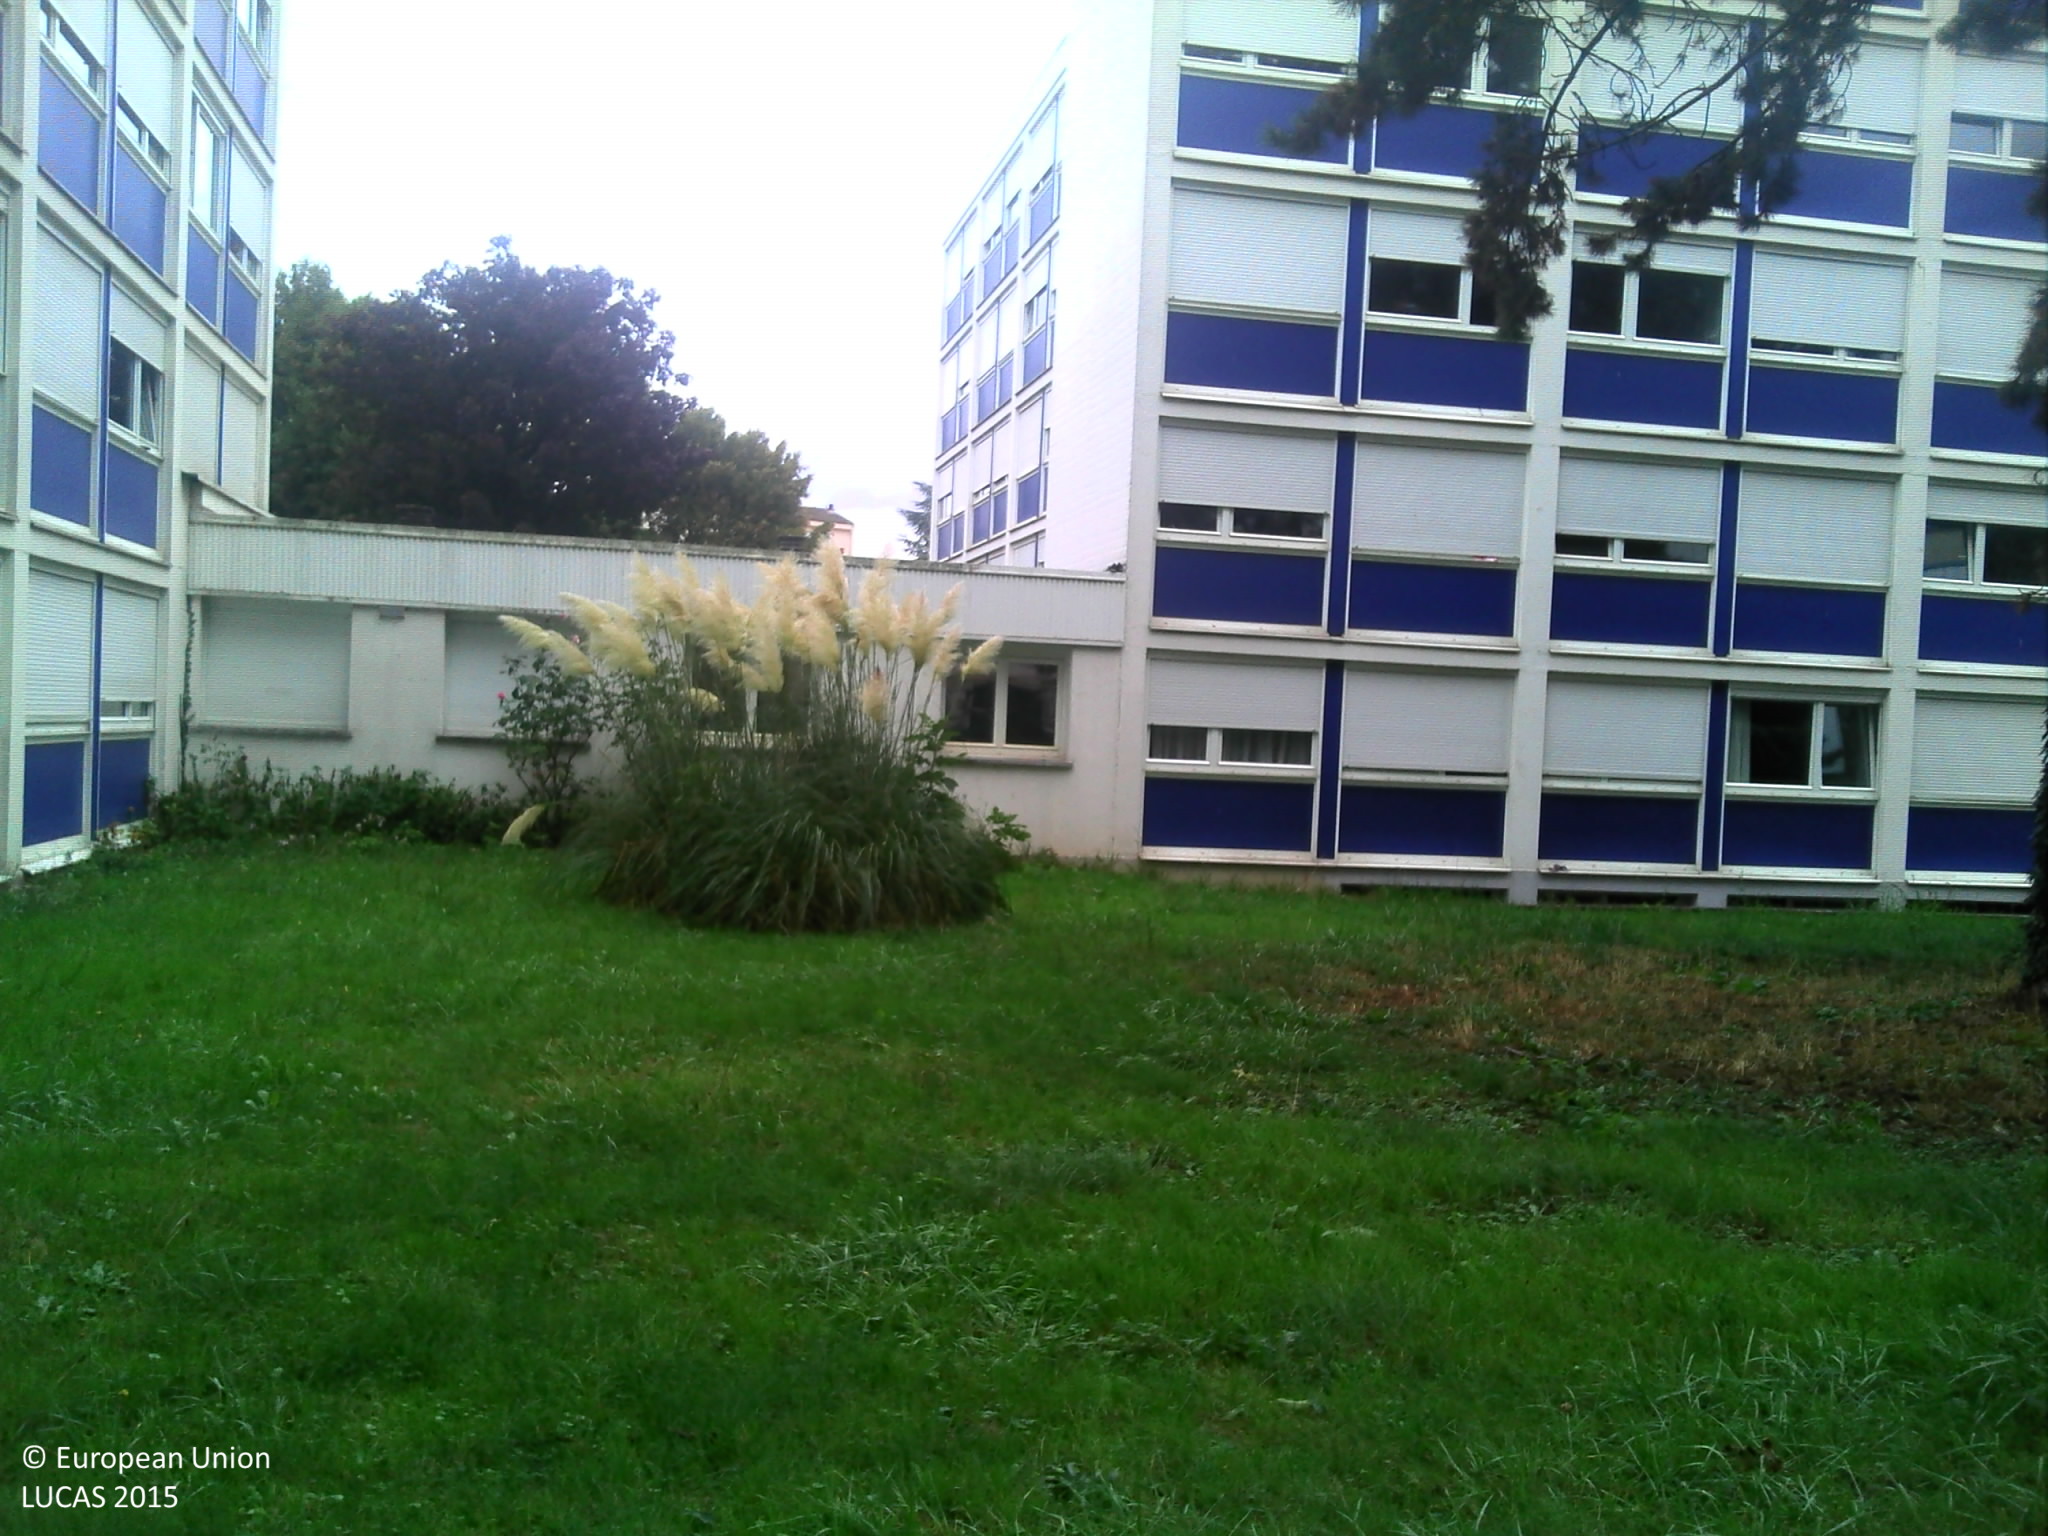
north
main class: Grassland
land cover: Grassland with sparse tree/shrub cover
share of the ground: > 75 %
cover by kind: herbaceous plants 85 %, consolidated bare surface 10 %, broadleaved forest trees 5 %
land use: Residential
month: September
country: FR
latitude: 48.6799
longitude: 6.1835
